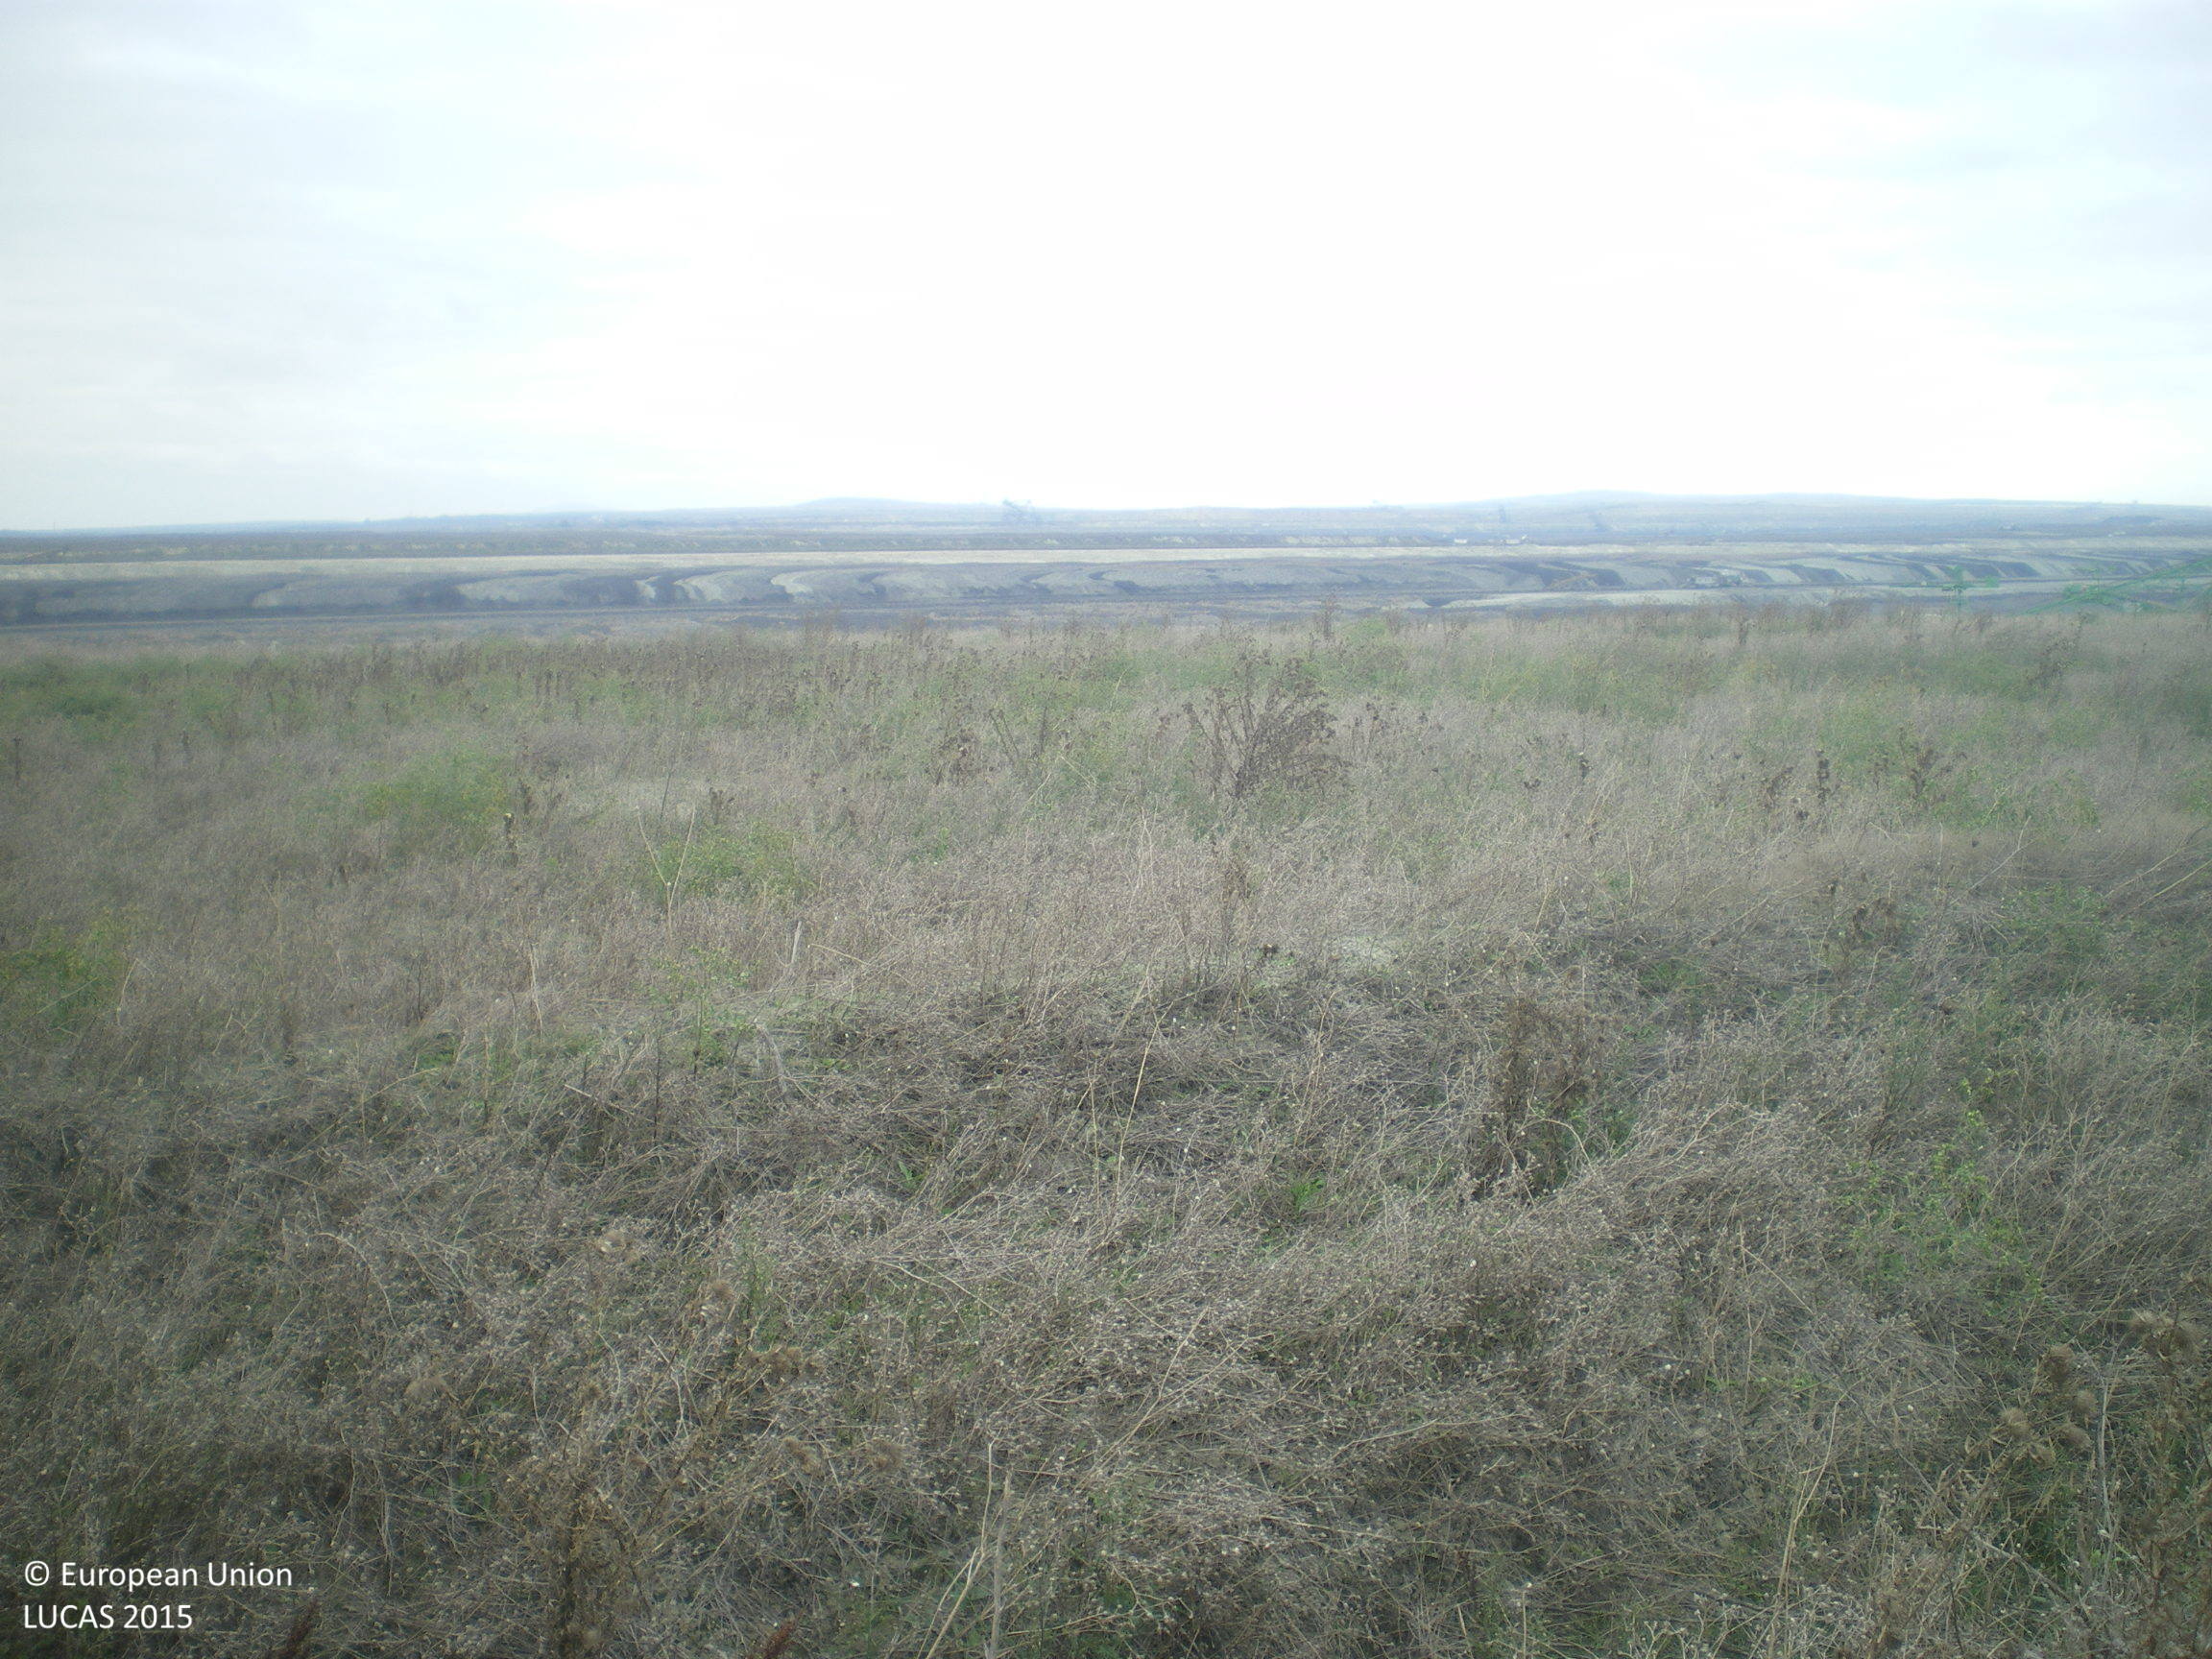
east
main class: Grassland
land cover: Grassland without tree/shrub cover
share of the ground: > 75 %
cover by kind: herbaceous plants 100 %
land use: Mining and quarrying
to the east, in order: Grassland without tree/shrub cover; Other bare soil; Other structural elements; Other bare soil; Other structural elements; Other bare soil
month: October
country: BG
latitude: 42.2204
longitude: 25.9835
